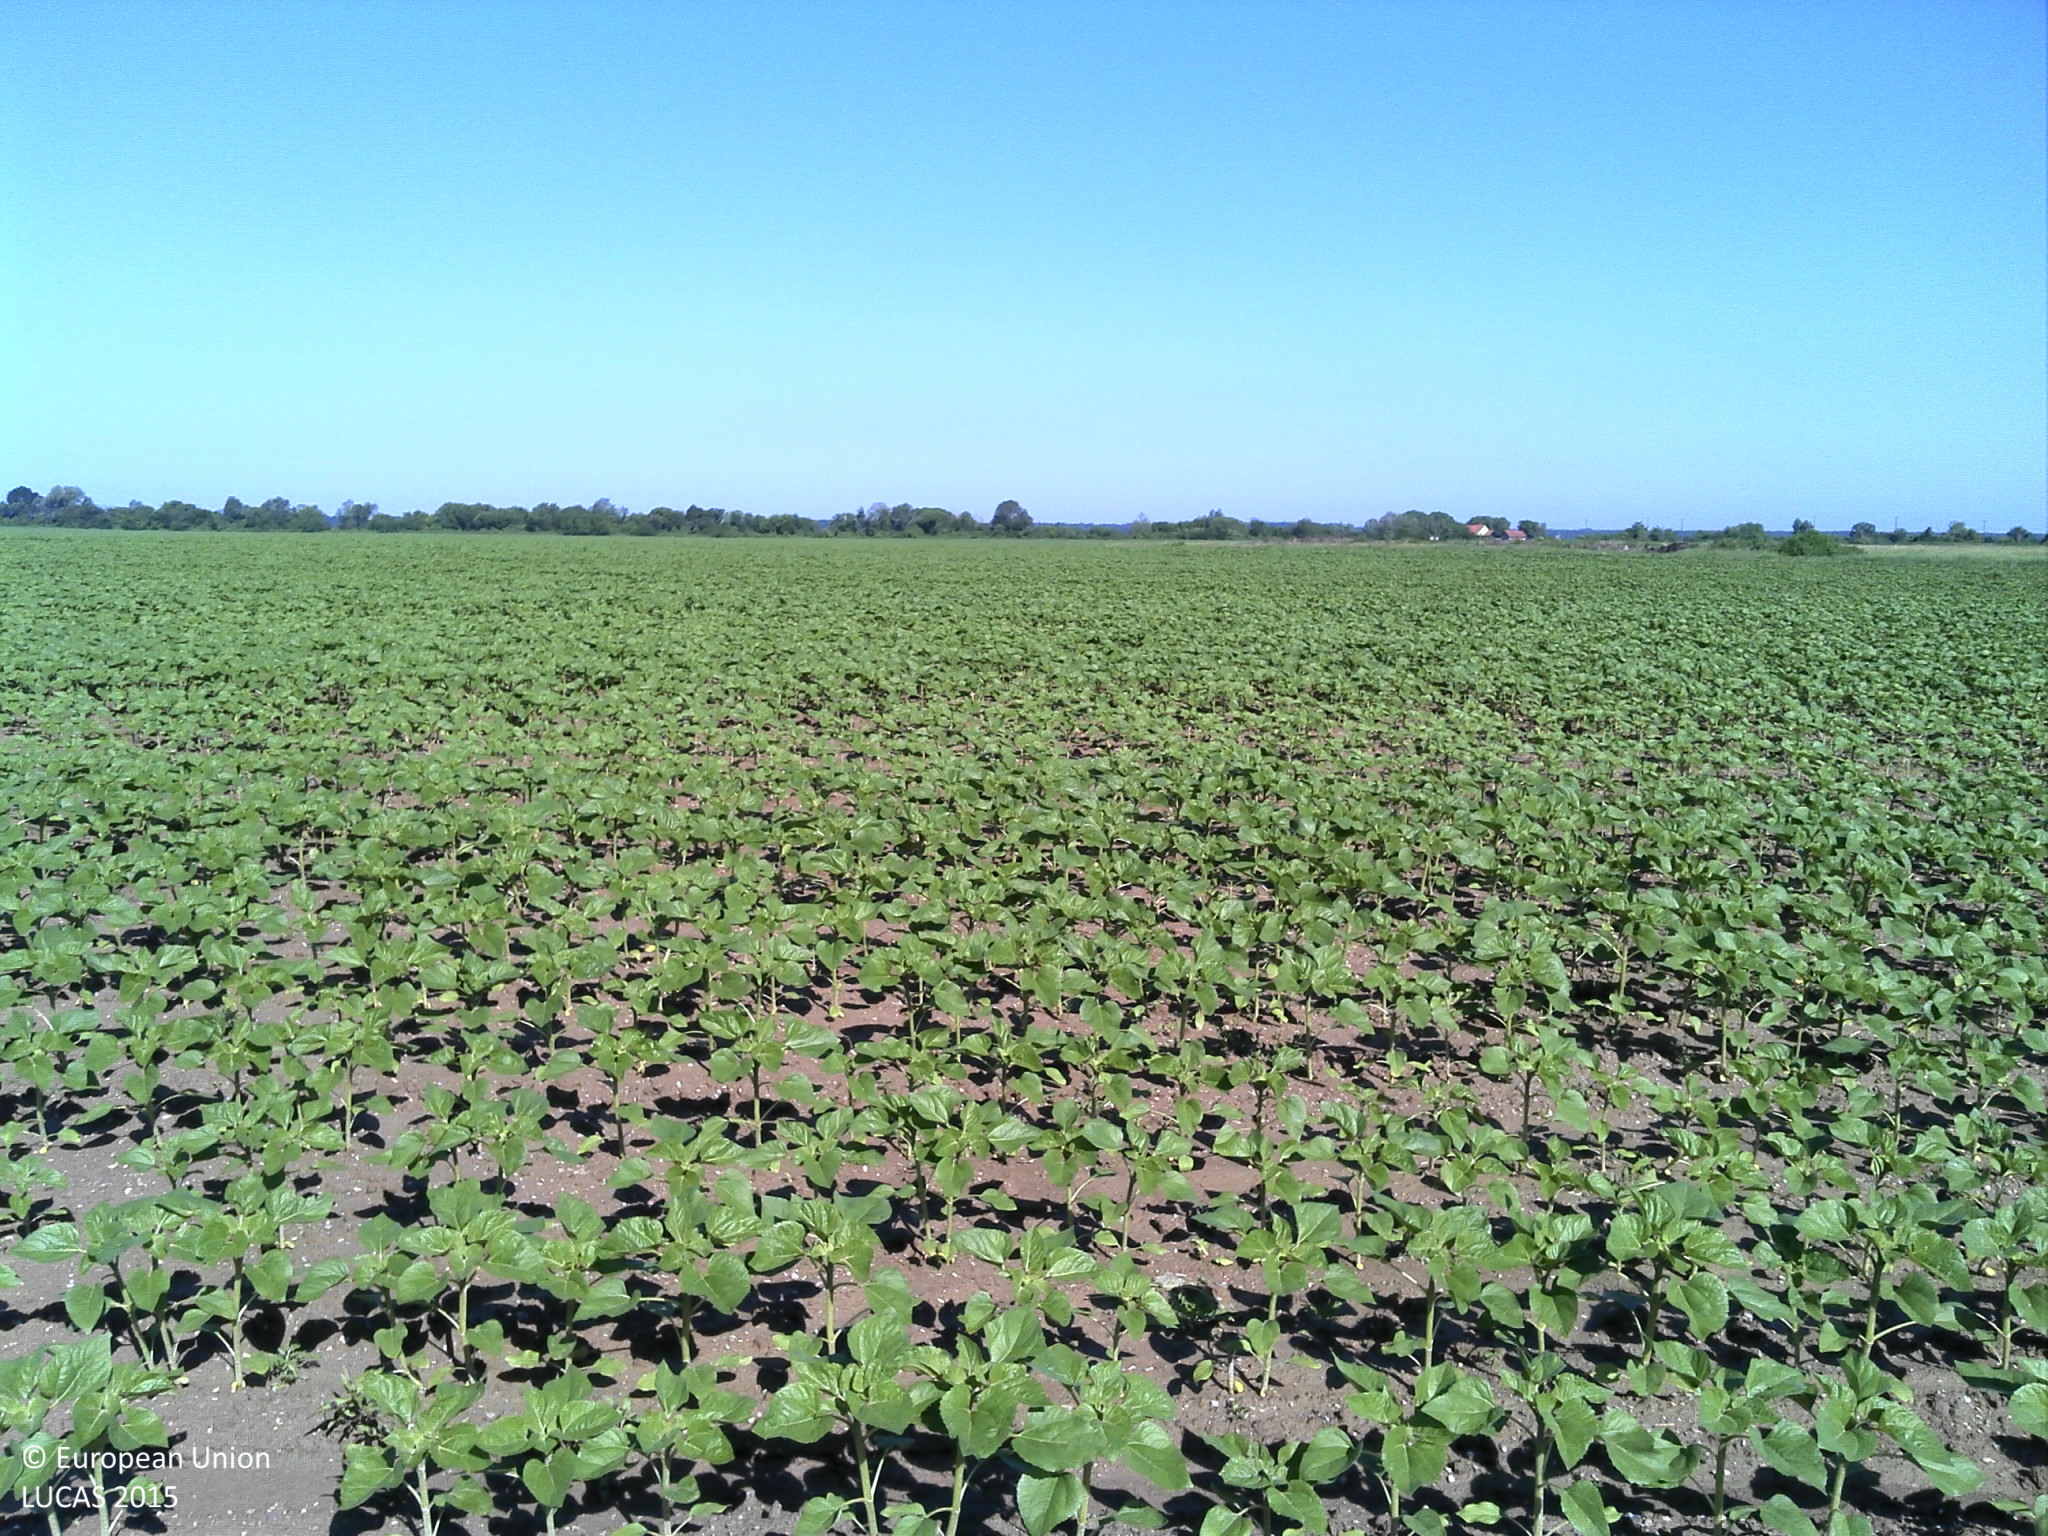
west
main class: Cropland
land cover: Sunflower
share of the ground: 25 - 50 %
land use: Agriculture (excluding fallow land and kitchen gardens)
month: May
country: HR
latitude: 45.5854
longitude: 17.9375
